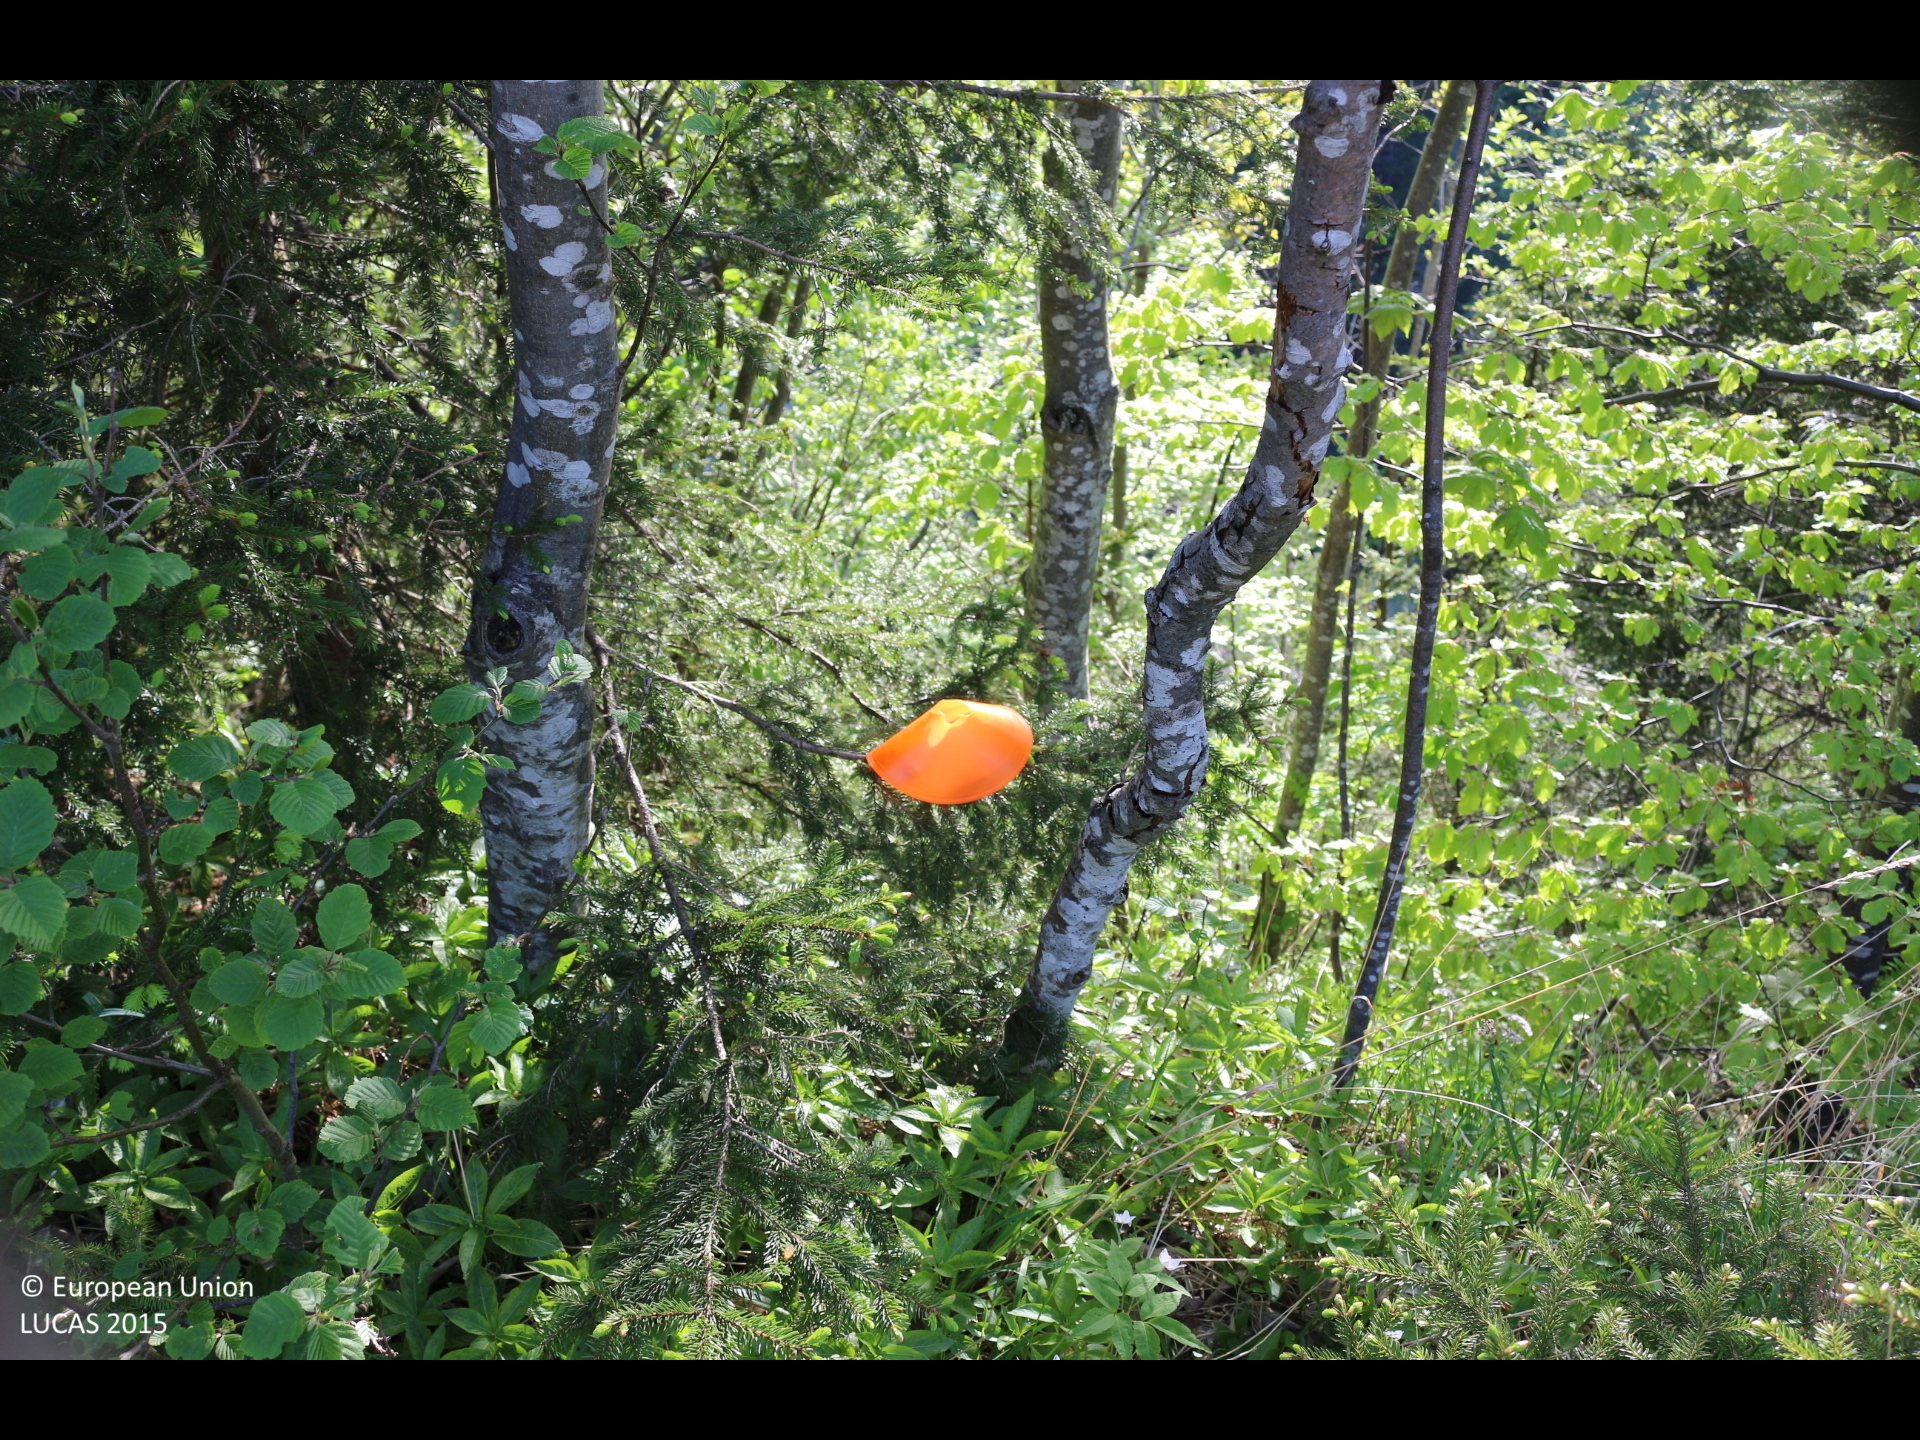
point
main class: Woodland
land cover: Spruce dominated mixed woodland
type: alpine coniferous forest
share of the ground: > 75 %
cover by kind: coniferous forest trees 60 %, broadleaved forest trees 40 %
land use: Forestry
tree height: > 5 m
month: May
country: AT
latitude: 46.4470
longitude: 14.2539
